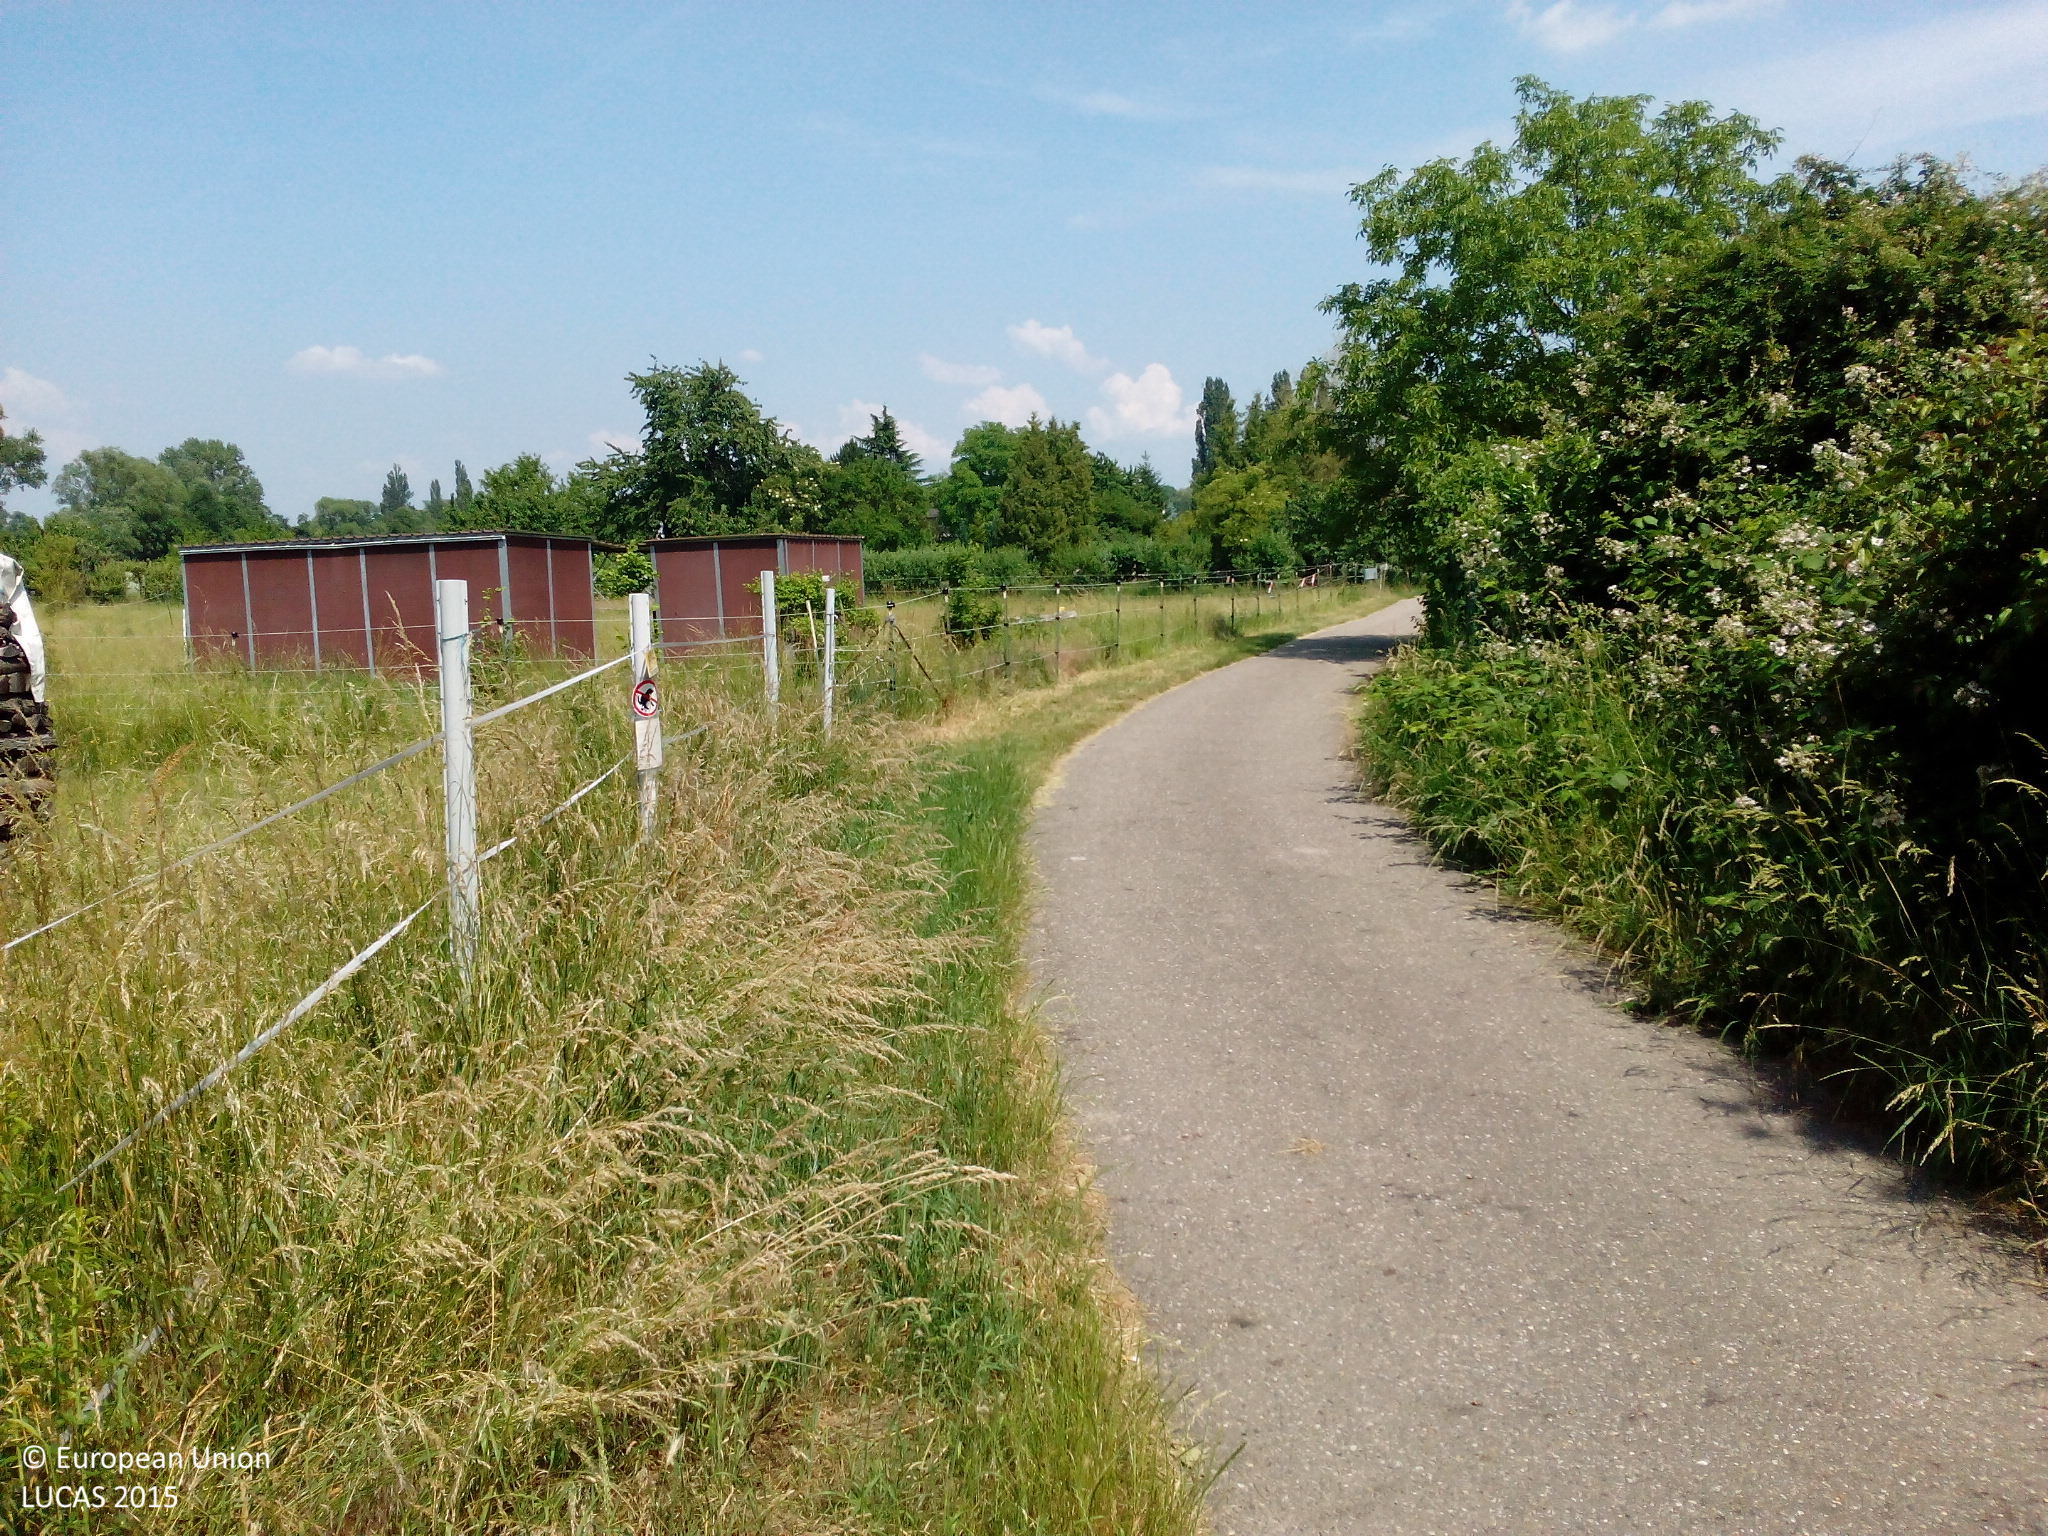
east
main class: Grassland
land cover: Grassland without tree/shrub cover
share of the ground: > 75 %
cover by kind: herbaceous plants 80 %, unconsolidated bare surface 20 %
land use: Agriculture (excluding fallow land and kitchen gardens)
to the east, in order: Paved roads, cycling and walking lanes; Broadleaved woodland; Artificial constructions in urban areas
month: June
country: DE
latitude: 49.2702
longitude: 8.1727
